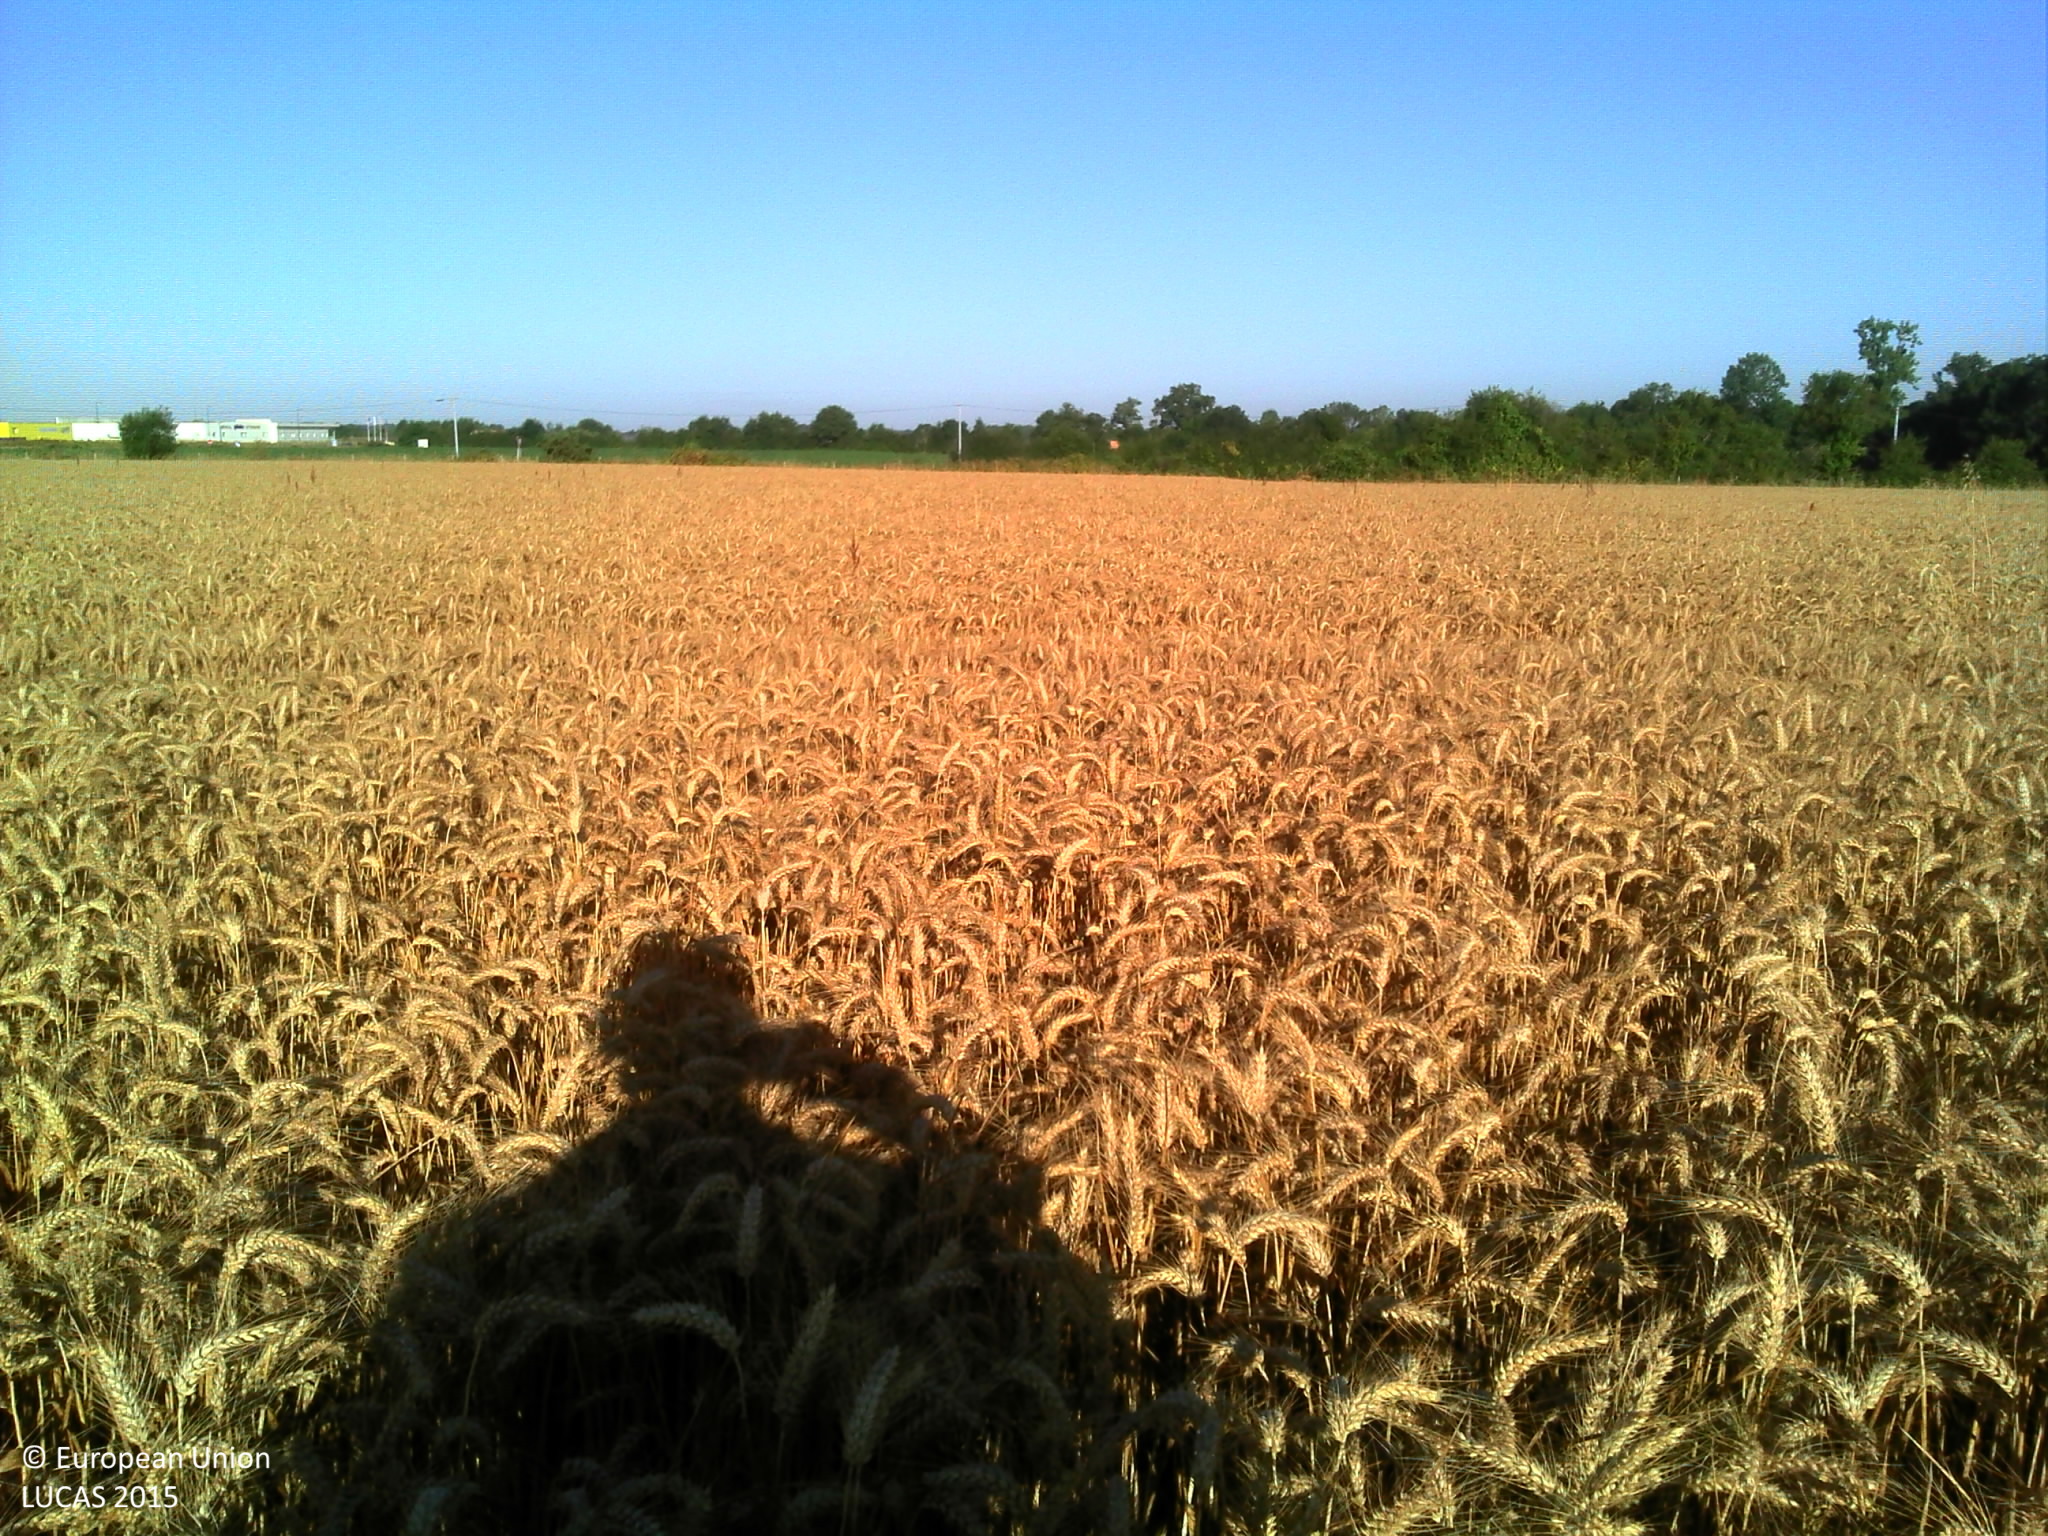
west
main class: Cropland
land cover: Common wheat
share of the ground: > 75 %
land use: Agriculture (excluding fallow land and kitchen gardens)
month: July
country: FR
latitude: 47.1307
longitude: -1.8178
